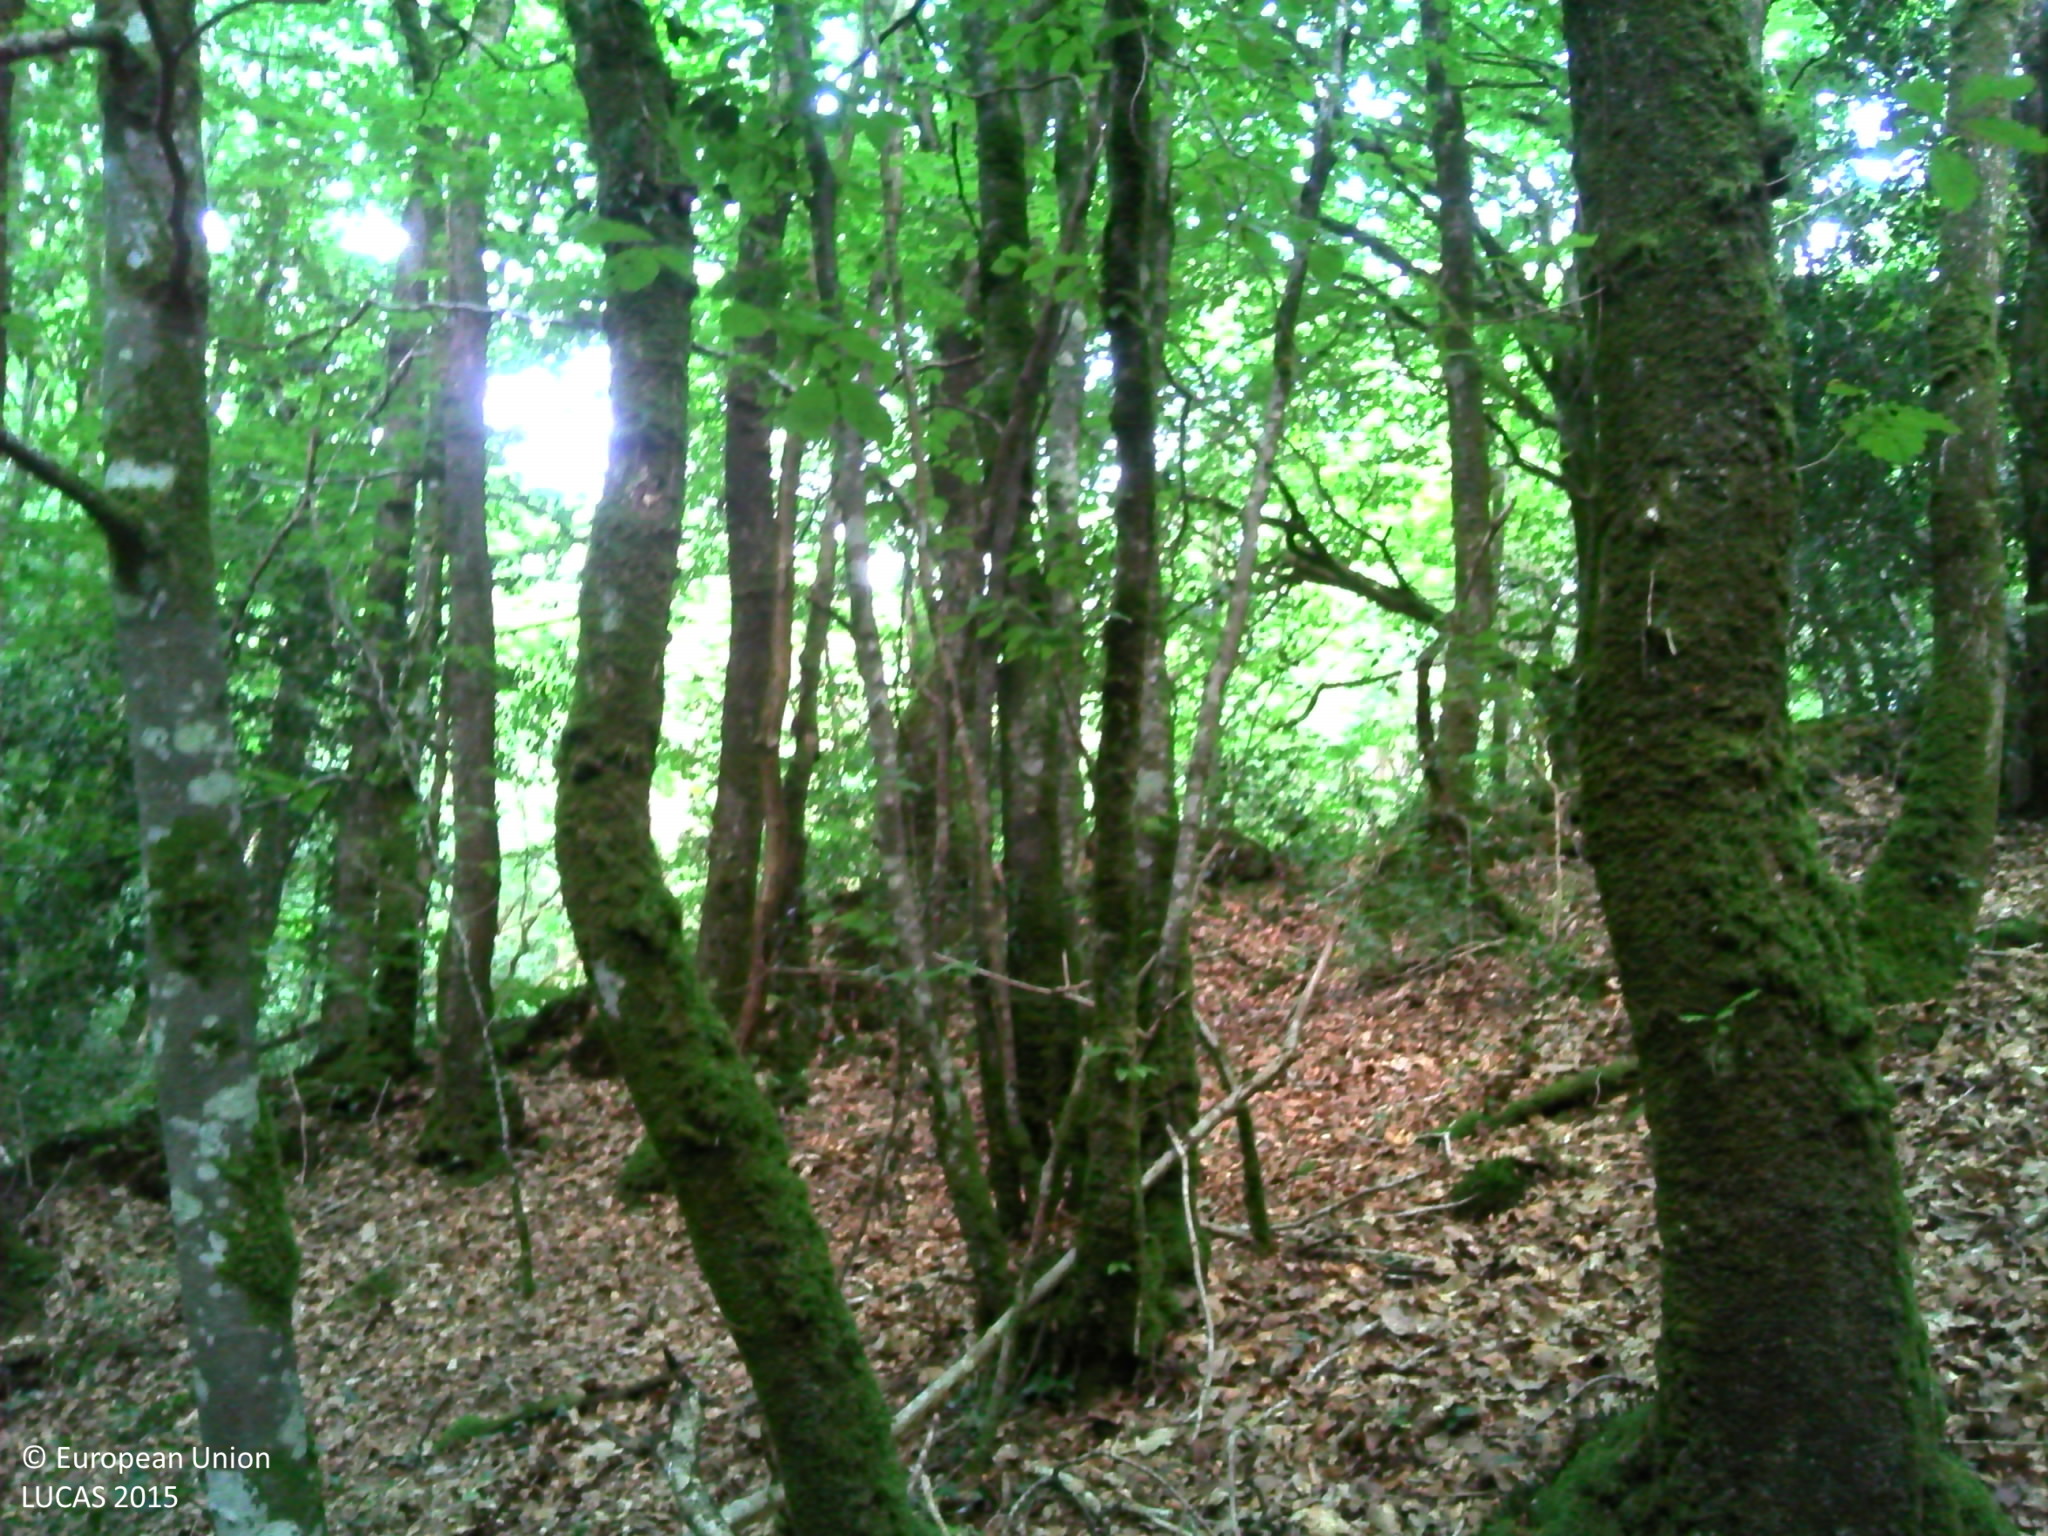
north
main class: Woodland
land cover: Broadleaved woodland
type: acidophilous oak and oak-birch forest
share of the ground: > 75 %
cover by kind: broadleaved forest trees 80 %, shrubs 10 %, herbaceous plants 10 %
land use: Forestry
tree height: > 5 m
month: August
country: FR
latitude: 48.3499
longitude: -3.3949
